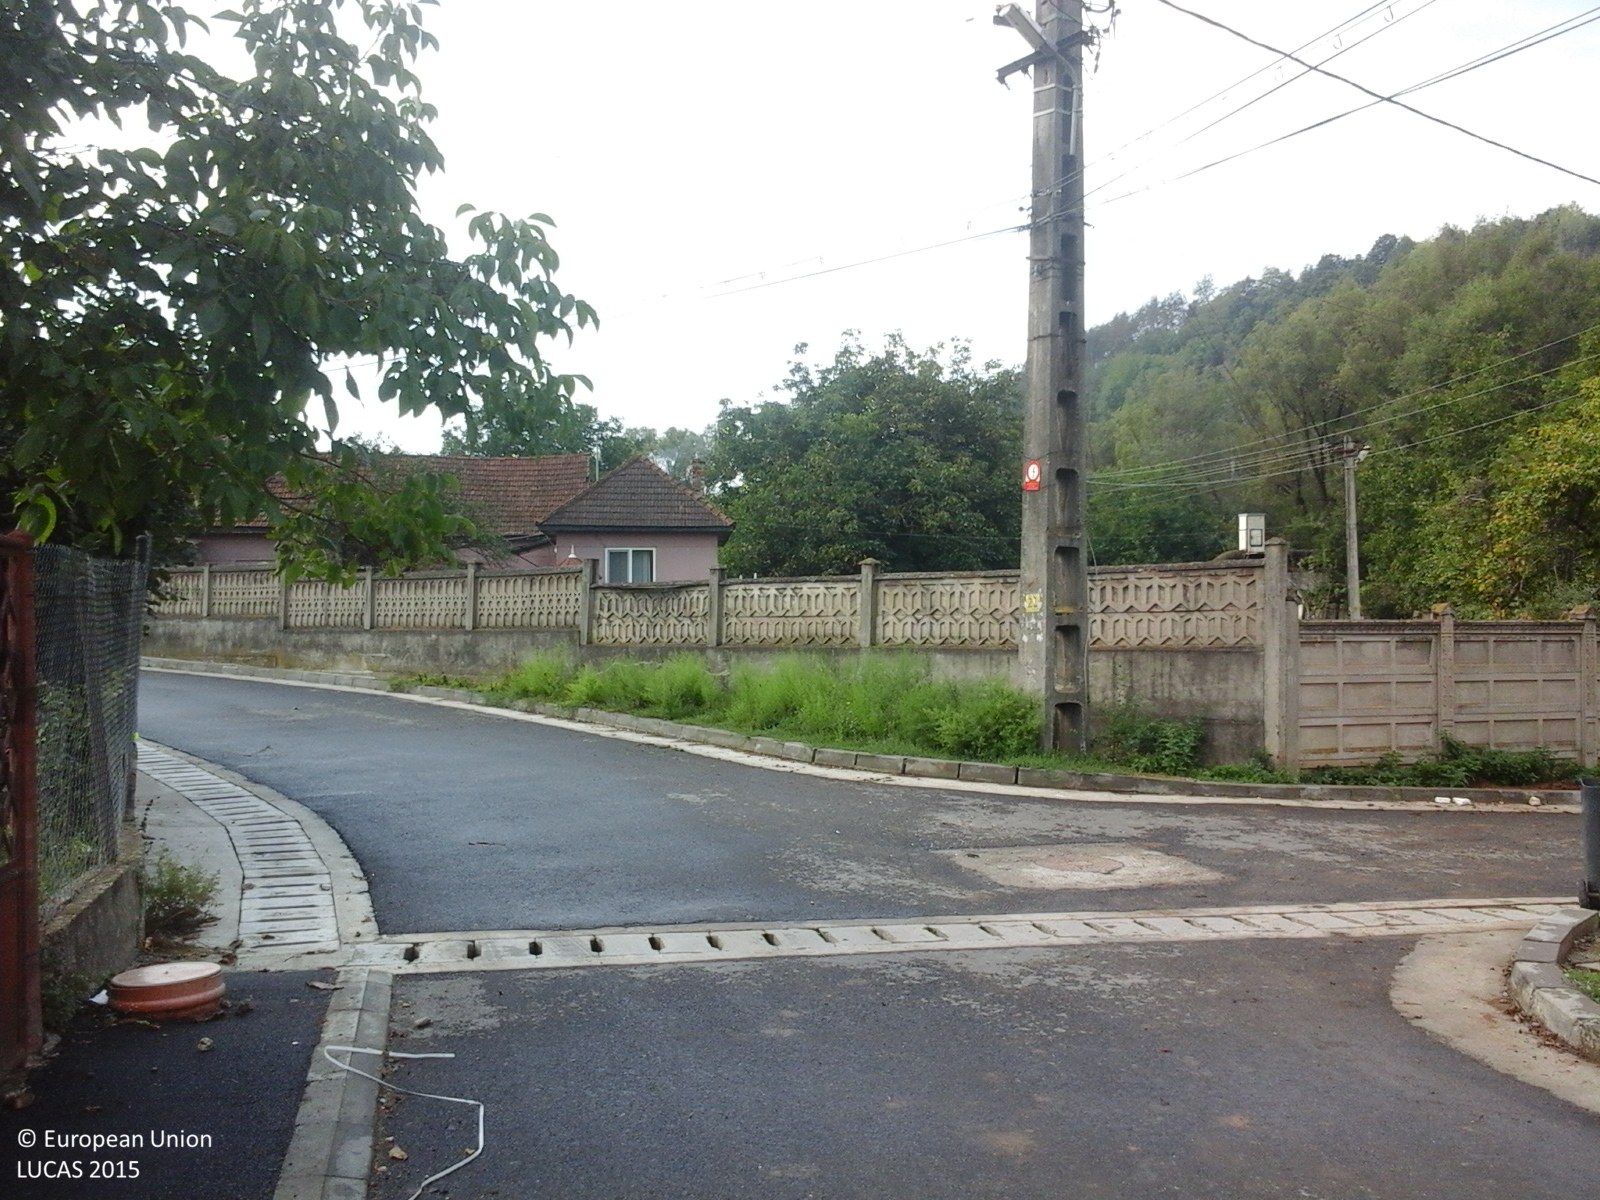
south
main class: Cropland
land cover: Apple fruit
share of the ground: 25 - 50 %
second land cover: Grassland without tree/shrub cover
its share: > 75 %
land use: Agriculture (excluding fallow land and kitchen gardens)
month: September
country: RO
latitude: 45.7138
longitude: 22.8860
